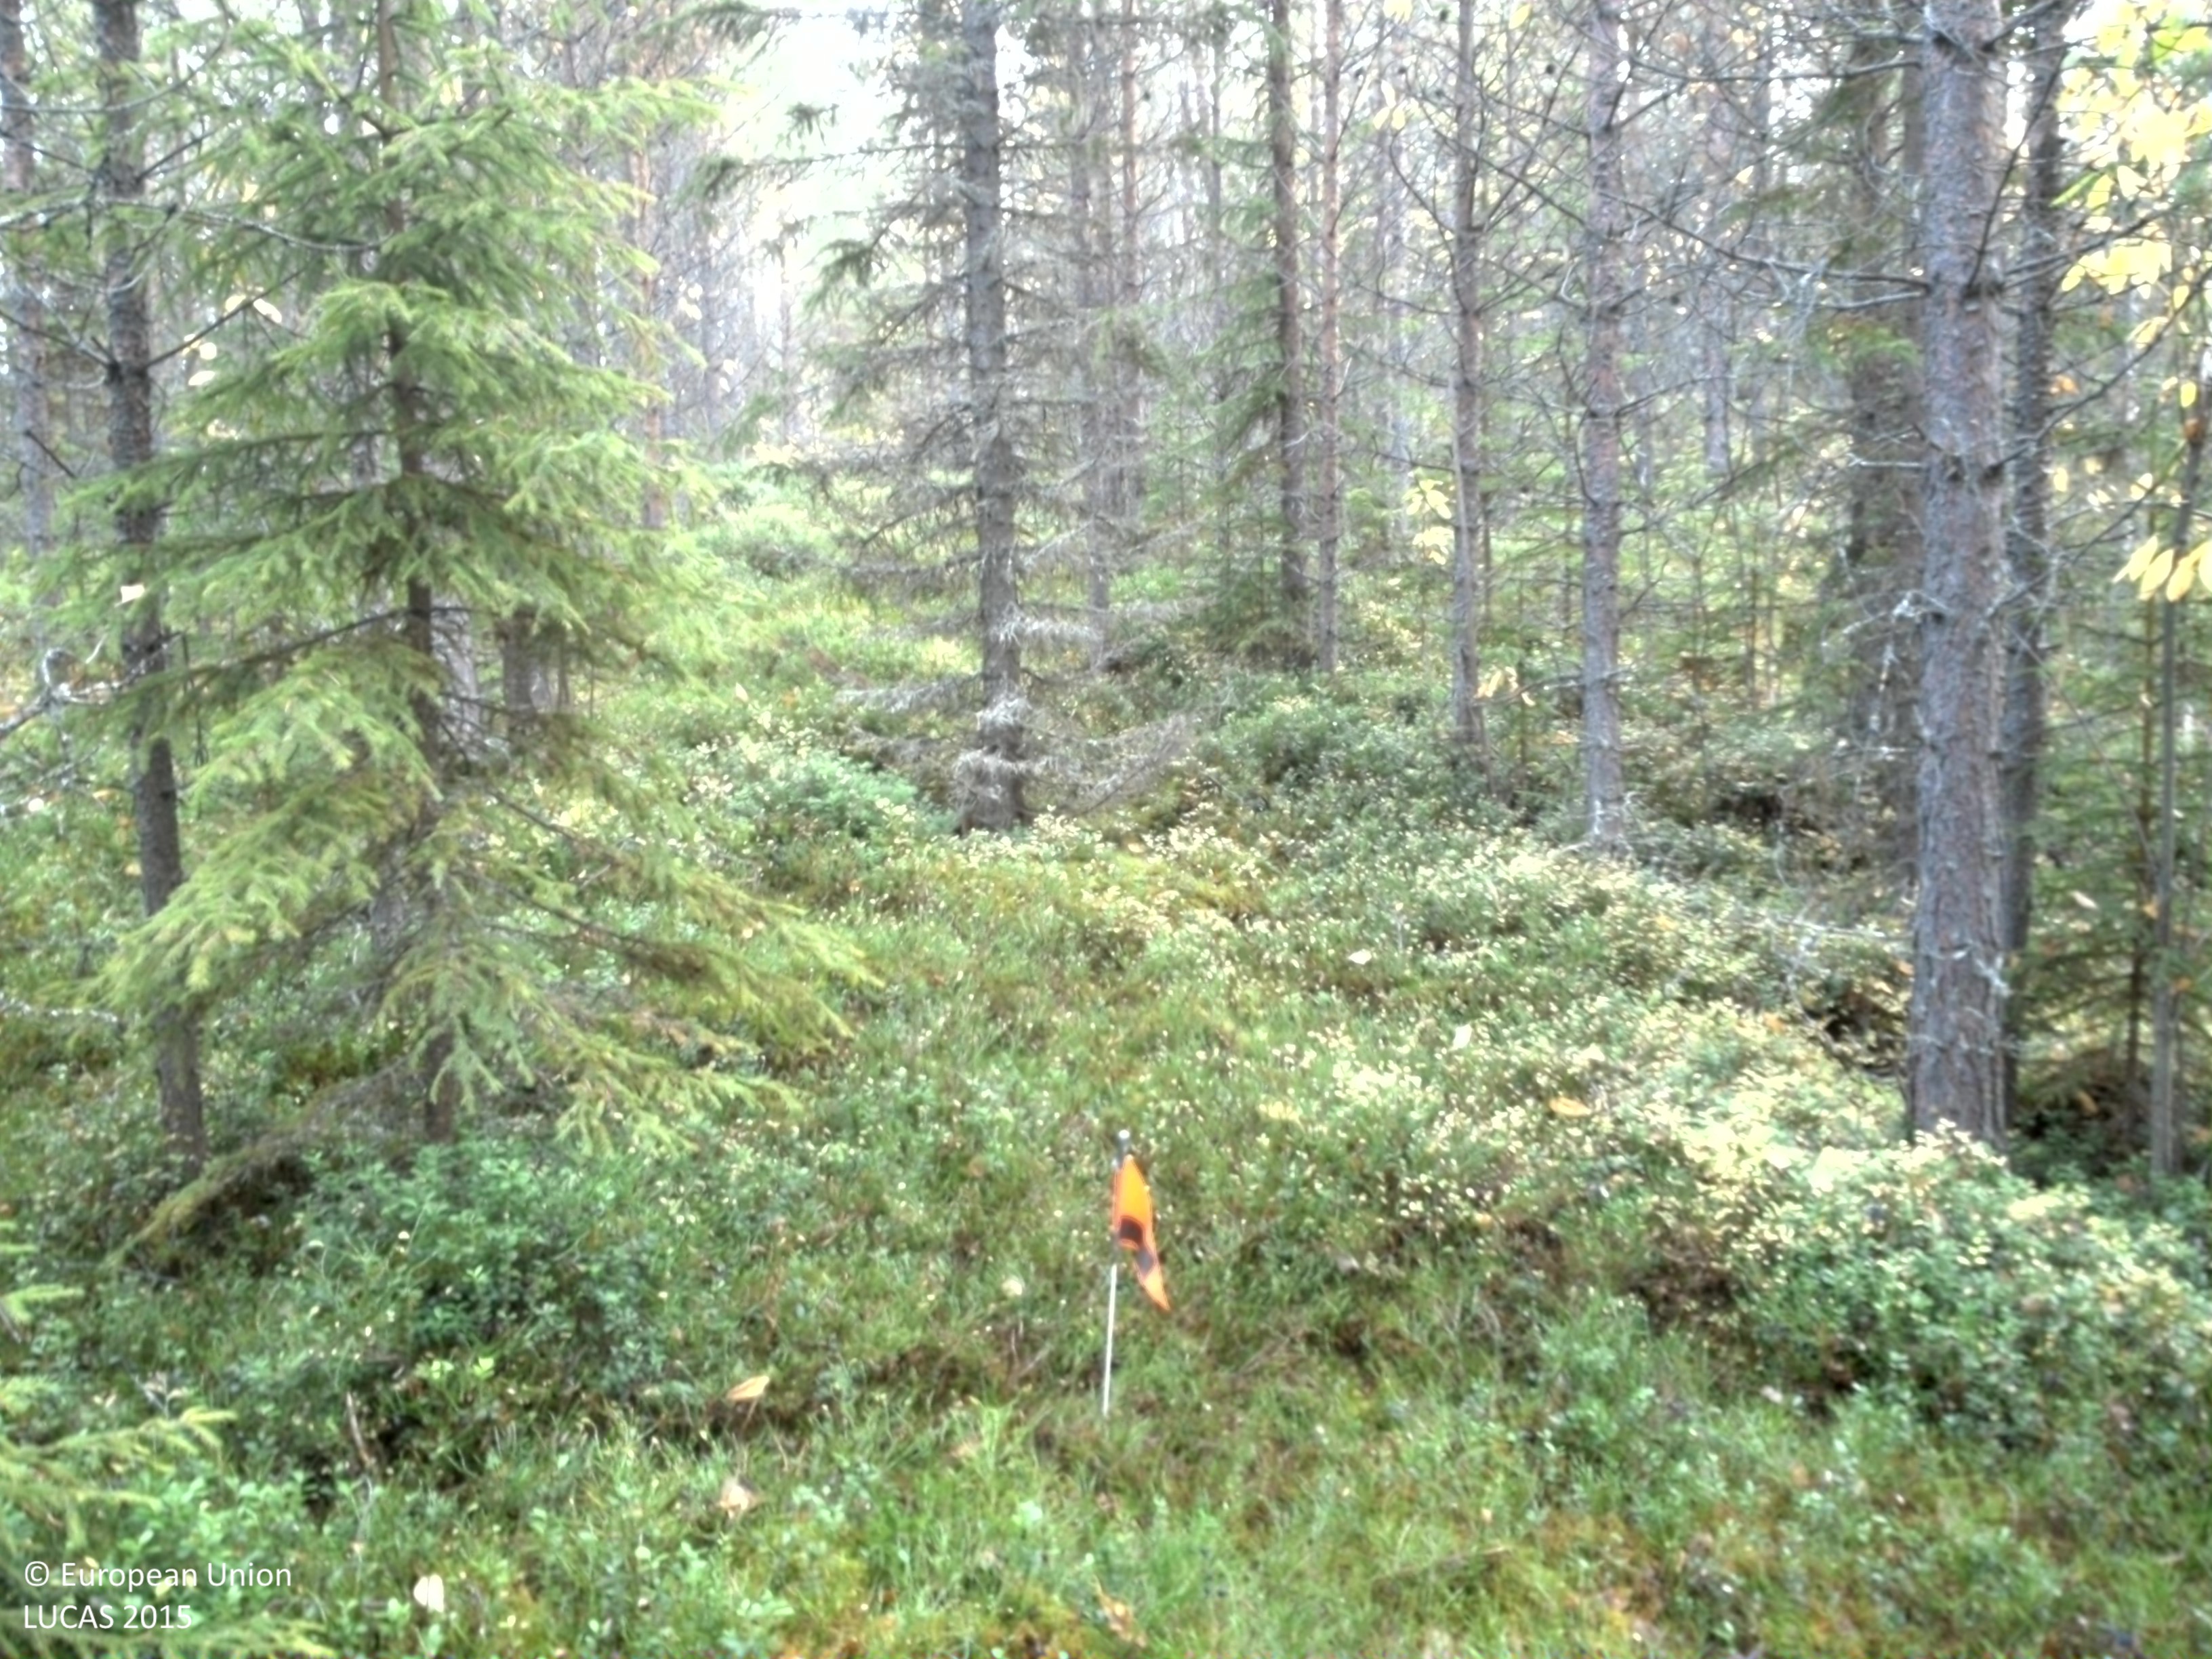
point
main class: Woodland
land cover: Pine dominated coniferous woodland
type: boreal forest
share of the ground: 25 - 50 %
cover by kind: shrubs 45 %, coniferous forest trees 35 %, lichens and mosses 15 %, broadleaved forest trees 5 %
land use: Forestry
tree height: > 5 m
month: September
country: SE
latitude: 64.9143
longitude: 17.8068
